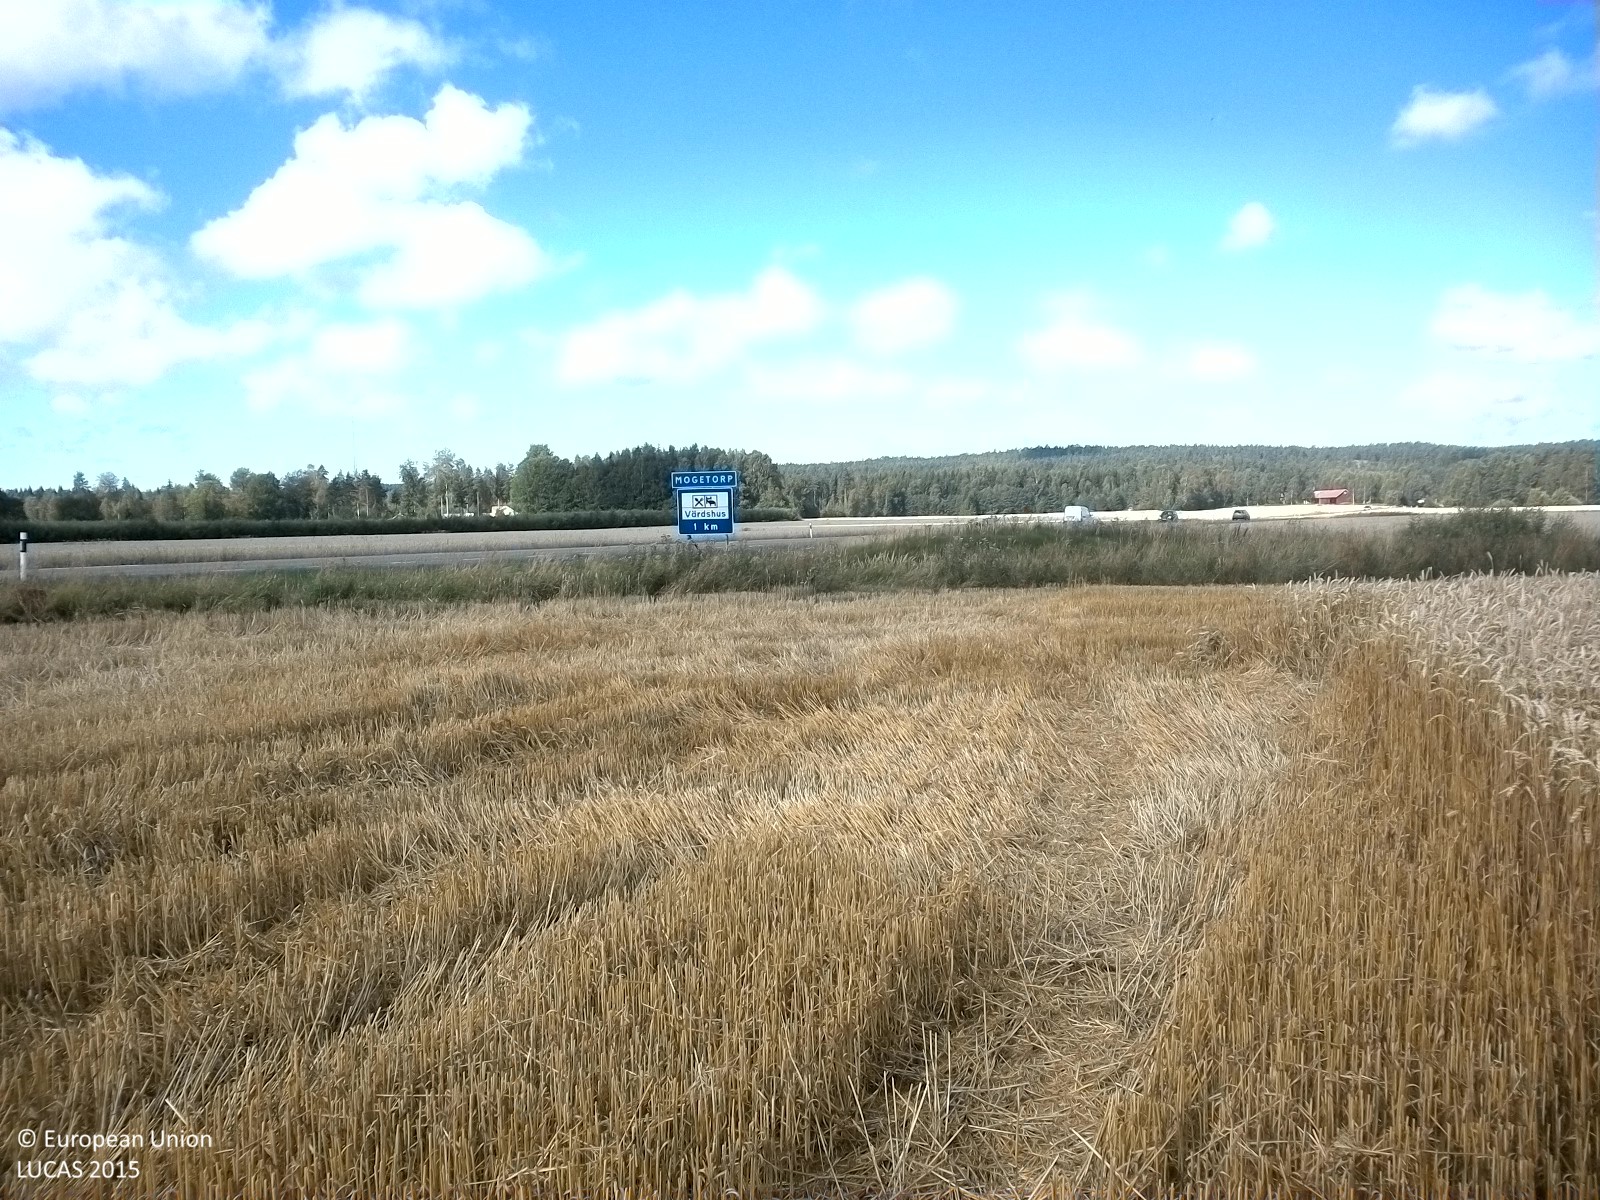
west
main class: Cropland
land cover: Common wheat
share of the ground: > 75 %
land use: Agriculture (excluding fallow land and kitchen gardens)
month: August
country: SE
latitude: 59.4370
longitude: 15.1571
